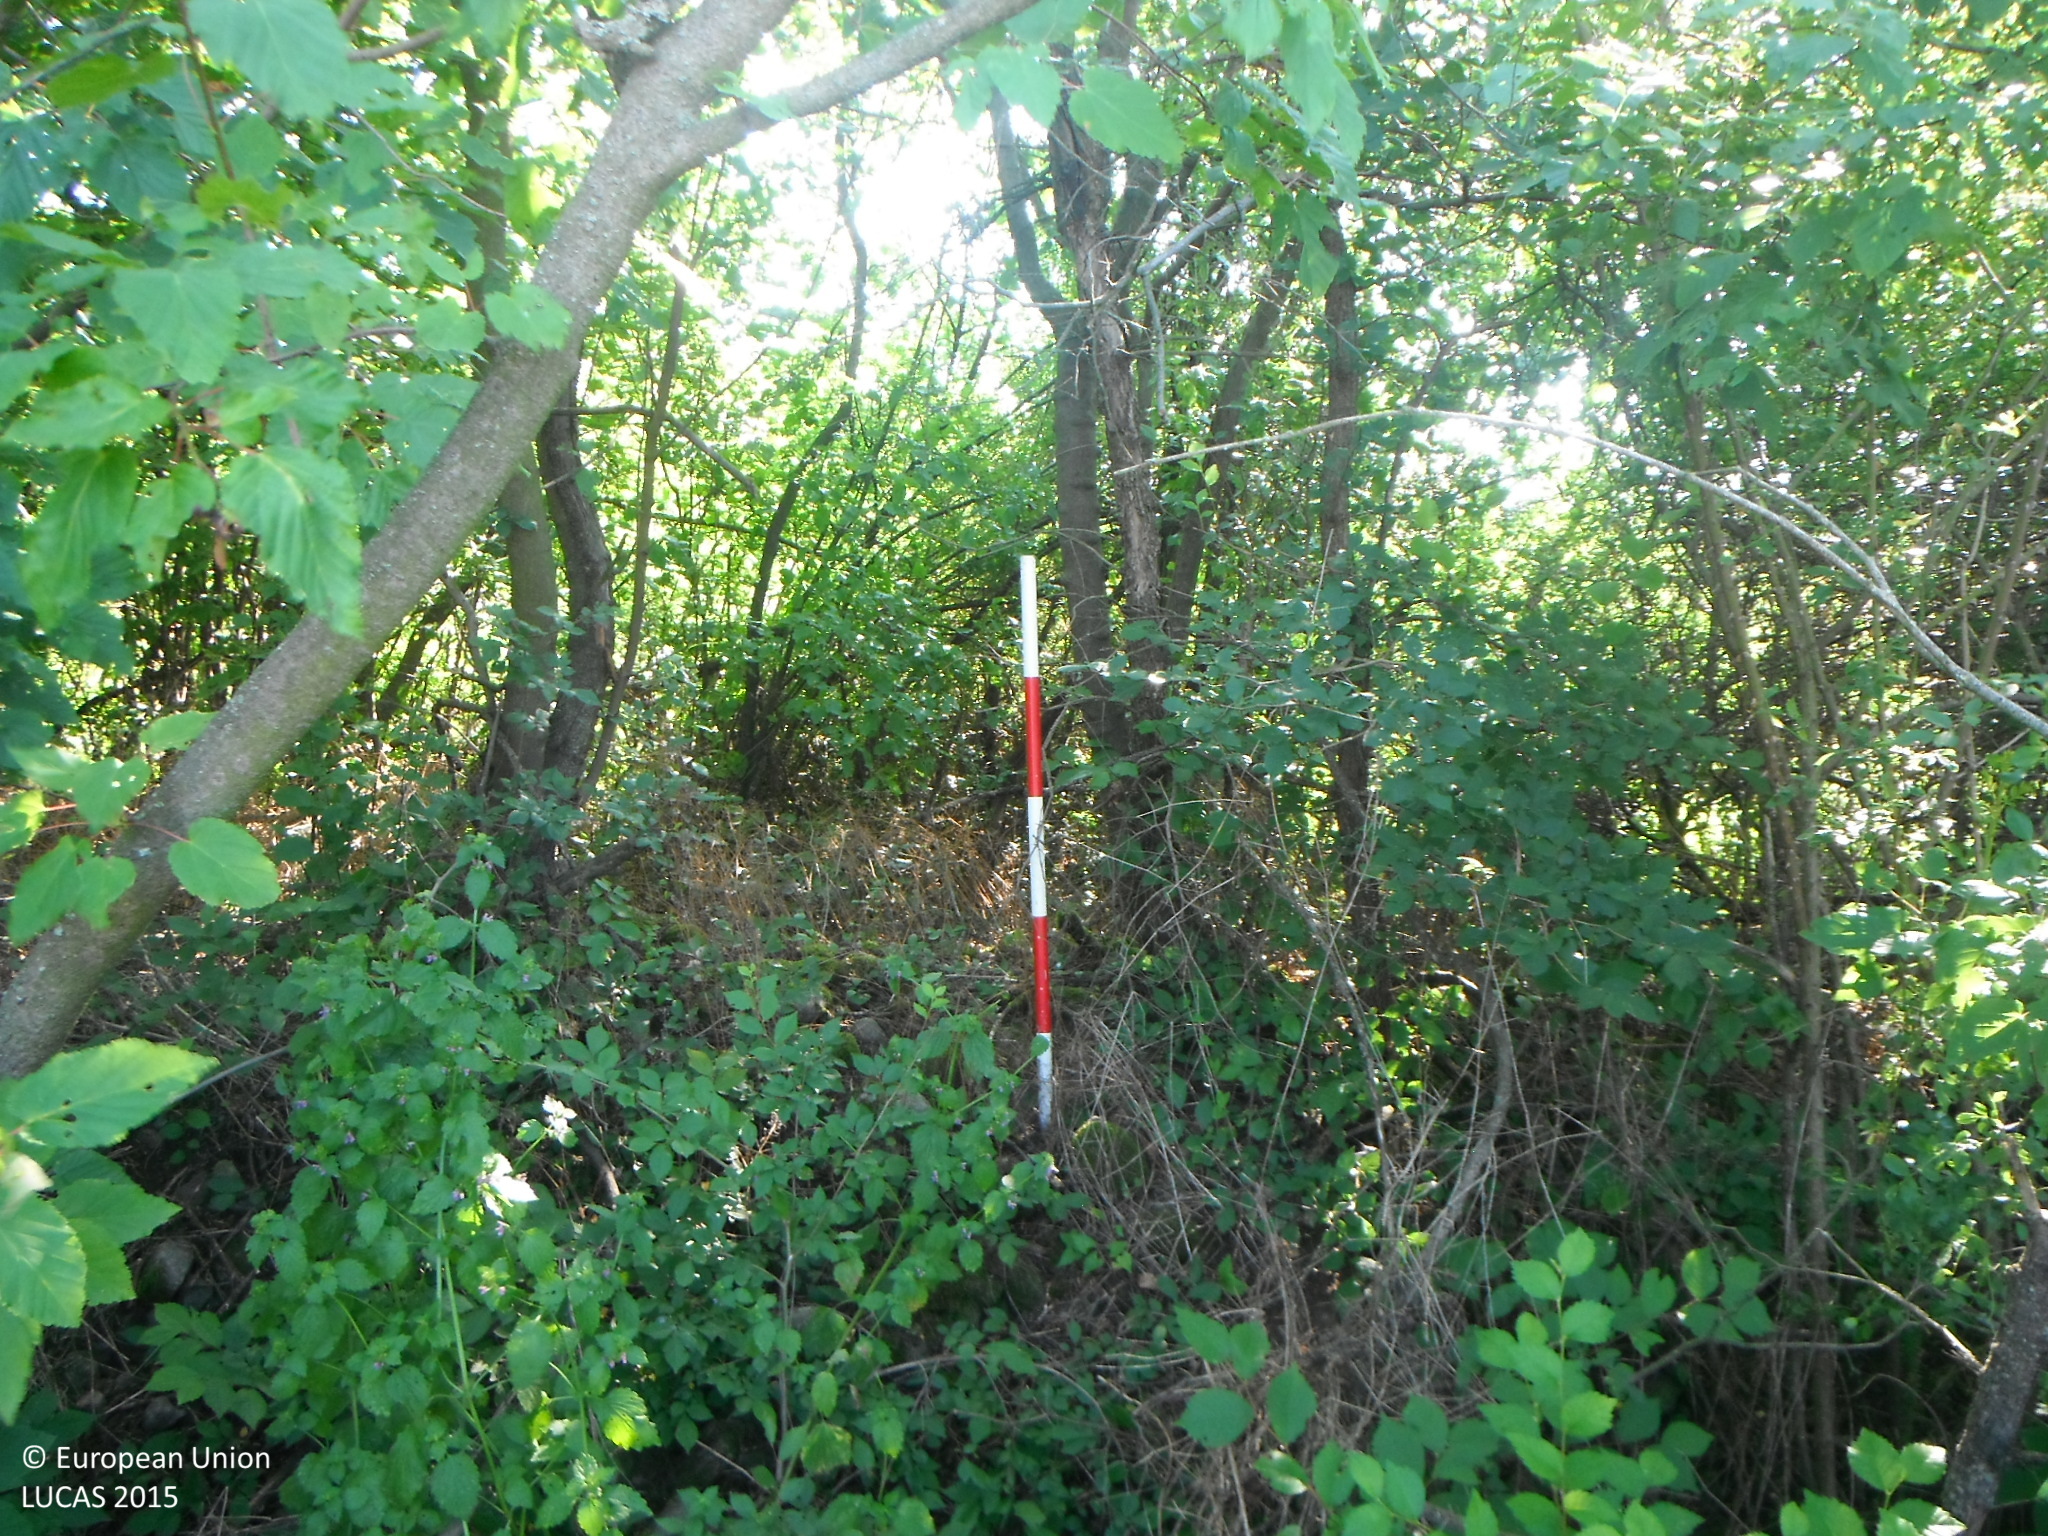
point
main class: Shrubland
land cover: Shrubland with sparse tree cover
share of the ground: > 75 %
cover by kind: shrubs 95 %, broadleaved forest trees 5 %
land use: Semi-natural and natural areas not in use
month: June
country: SK
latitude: 48.2058
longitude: 18.9136
